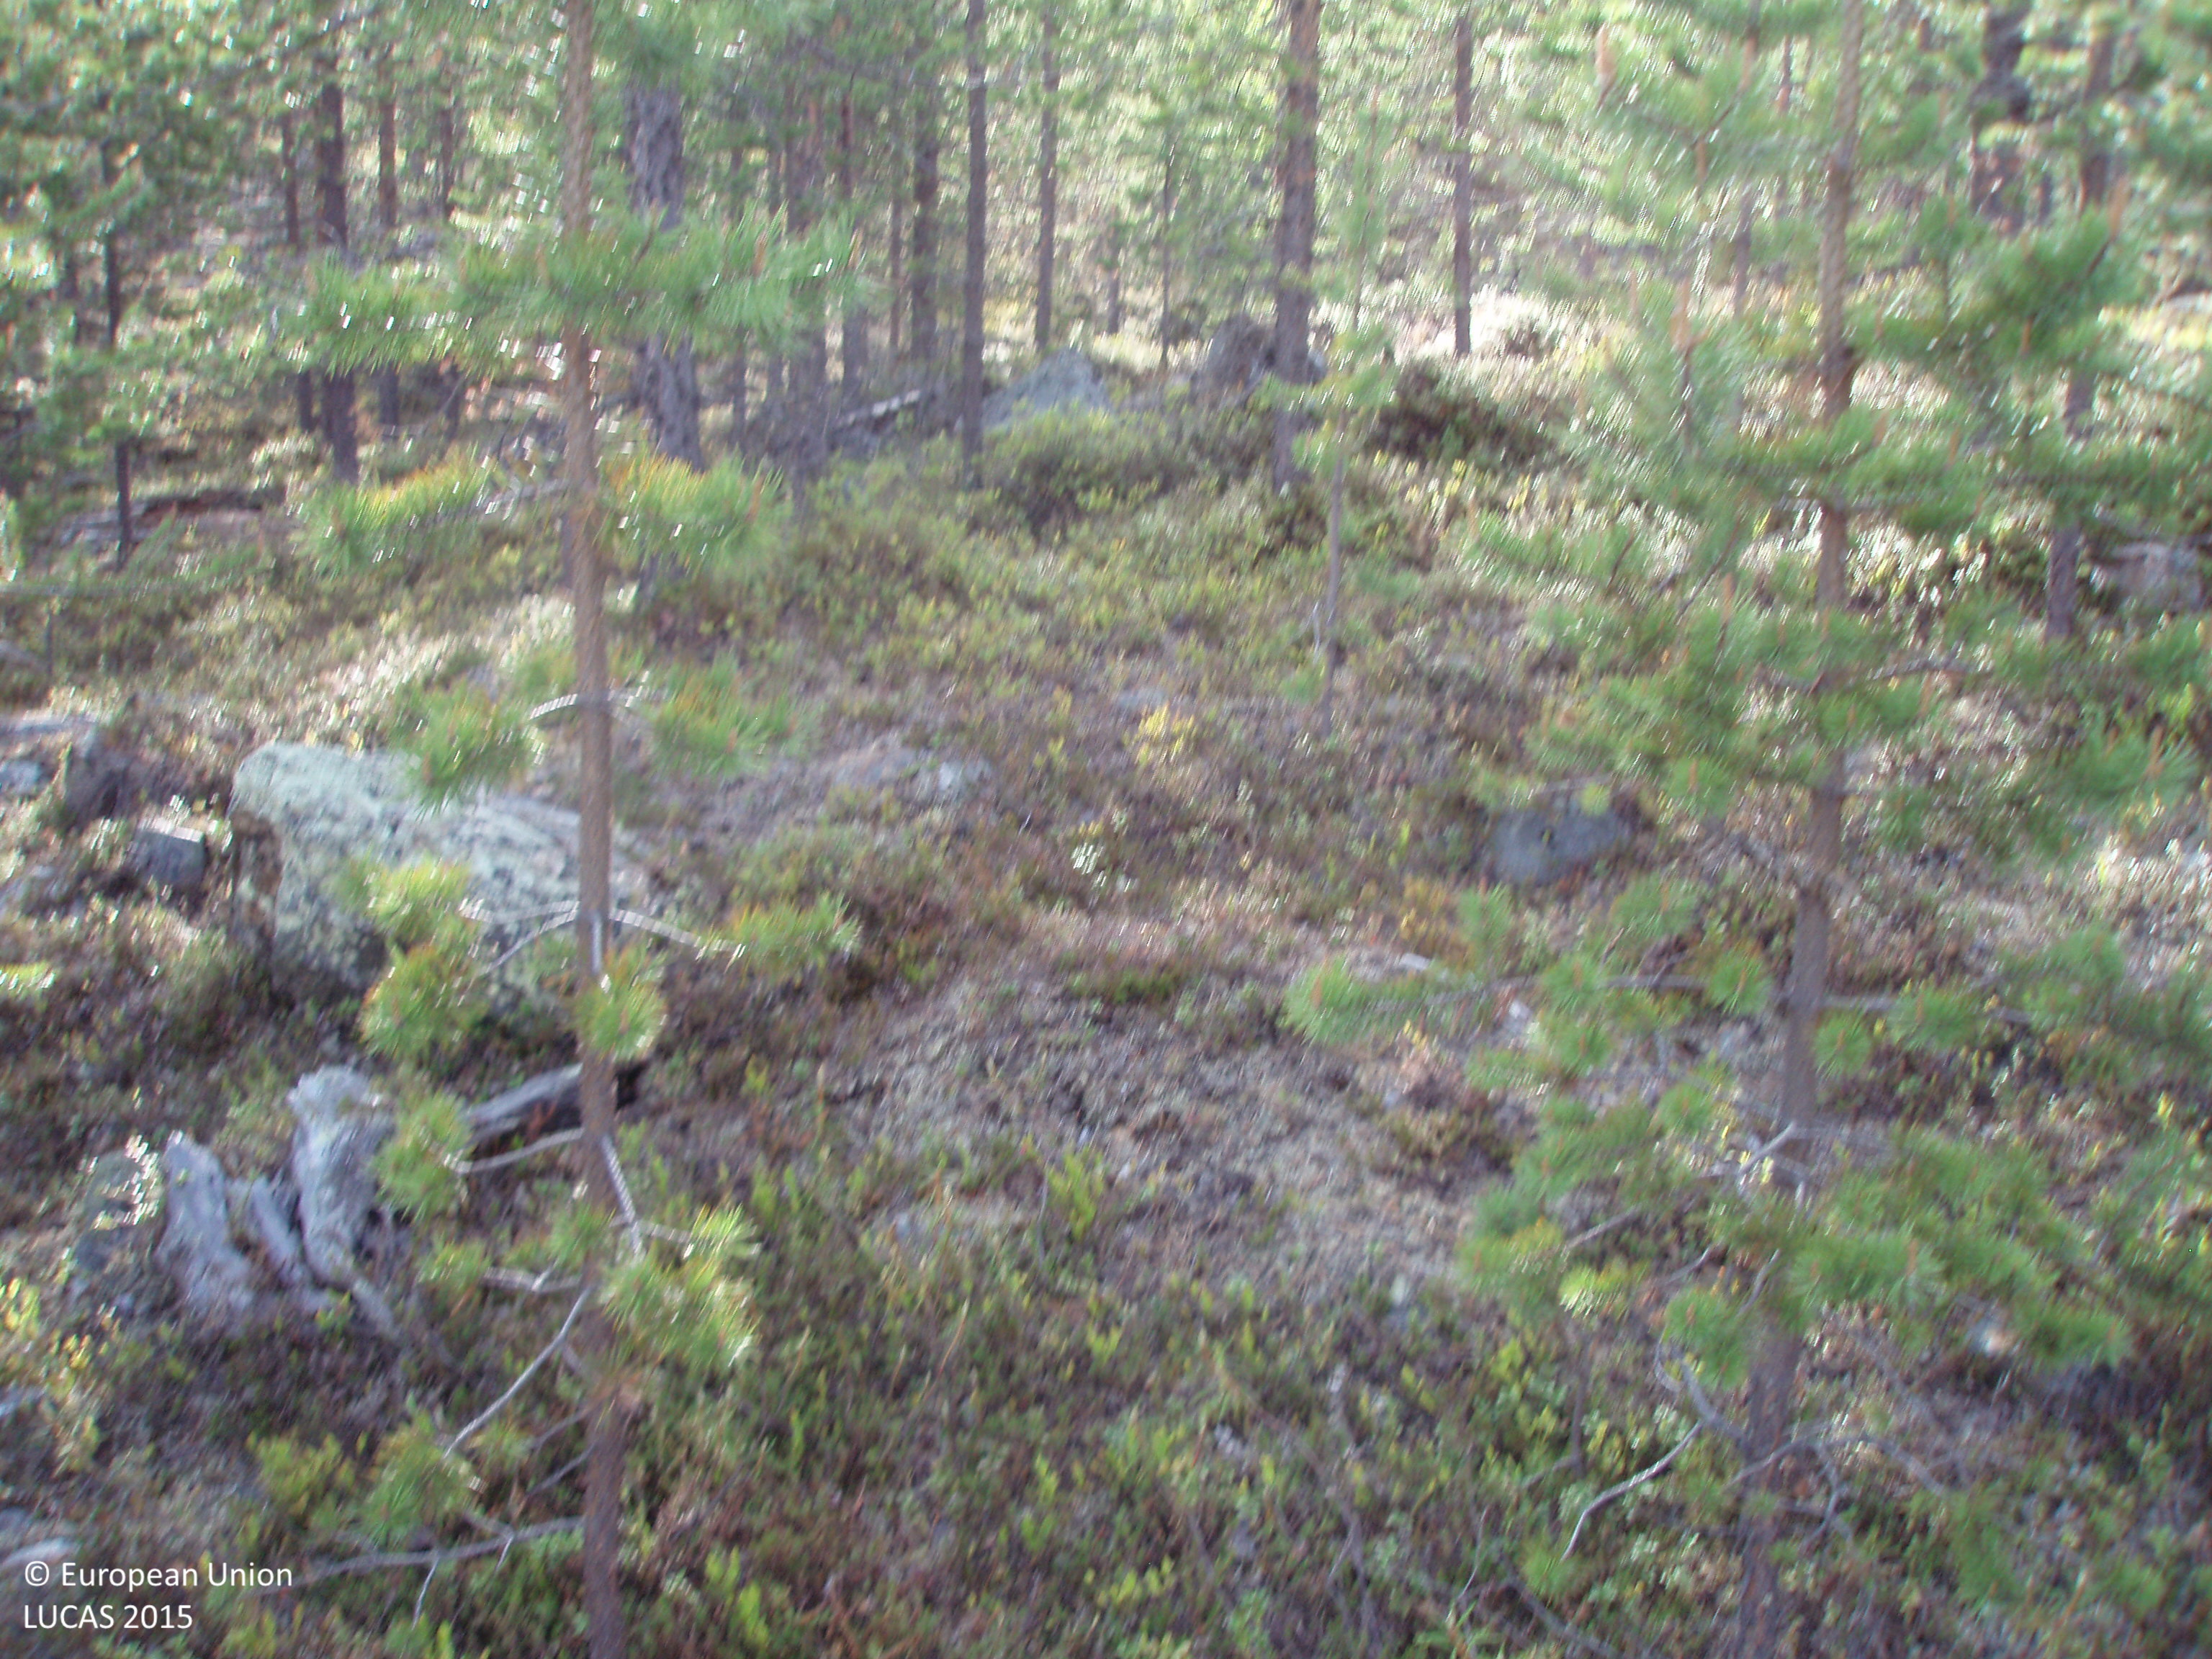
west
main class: Woodland
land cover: Pine dominated coniferous woodland
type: boreal forest
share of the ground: 50 - 75 %
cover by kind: coniferous forest trees 70 %, shrubs 30 %
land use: Forestry
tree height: > 5 m
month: June
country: FI
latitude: 68.4896
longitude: 28.2600
